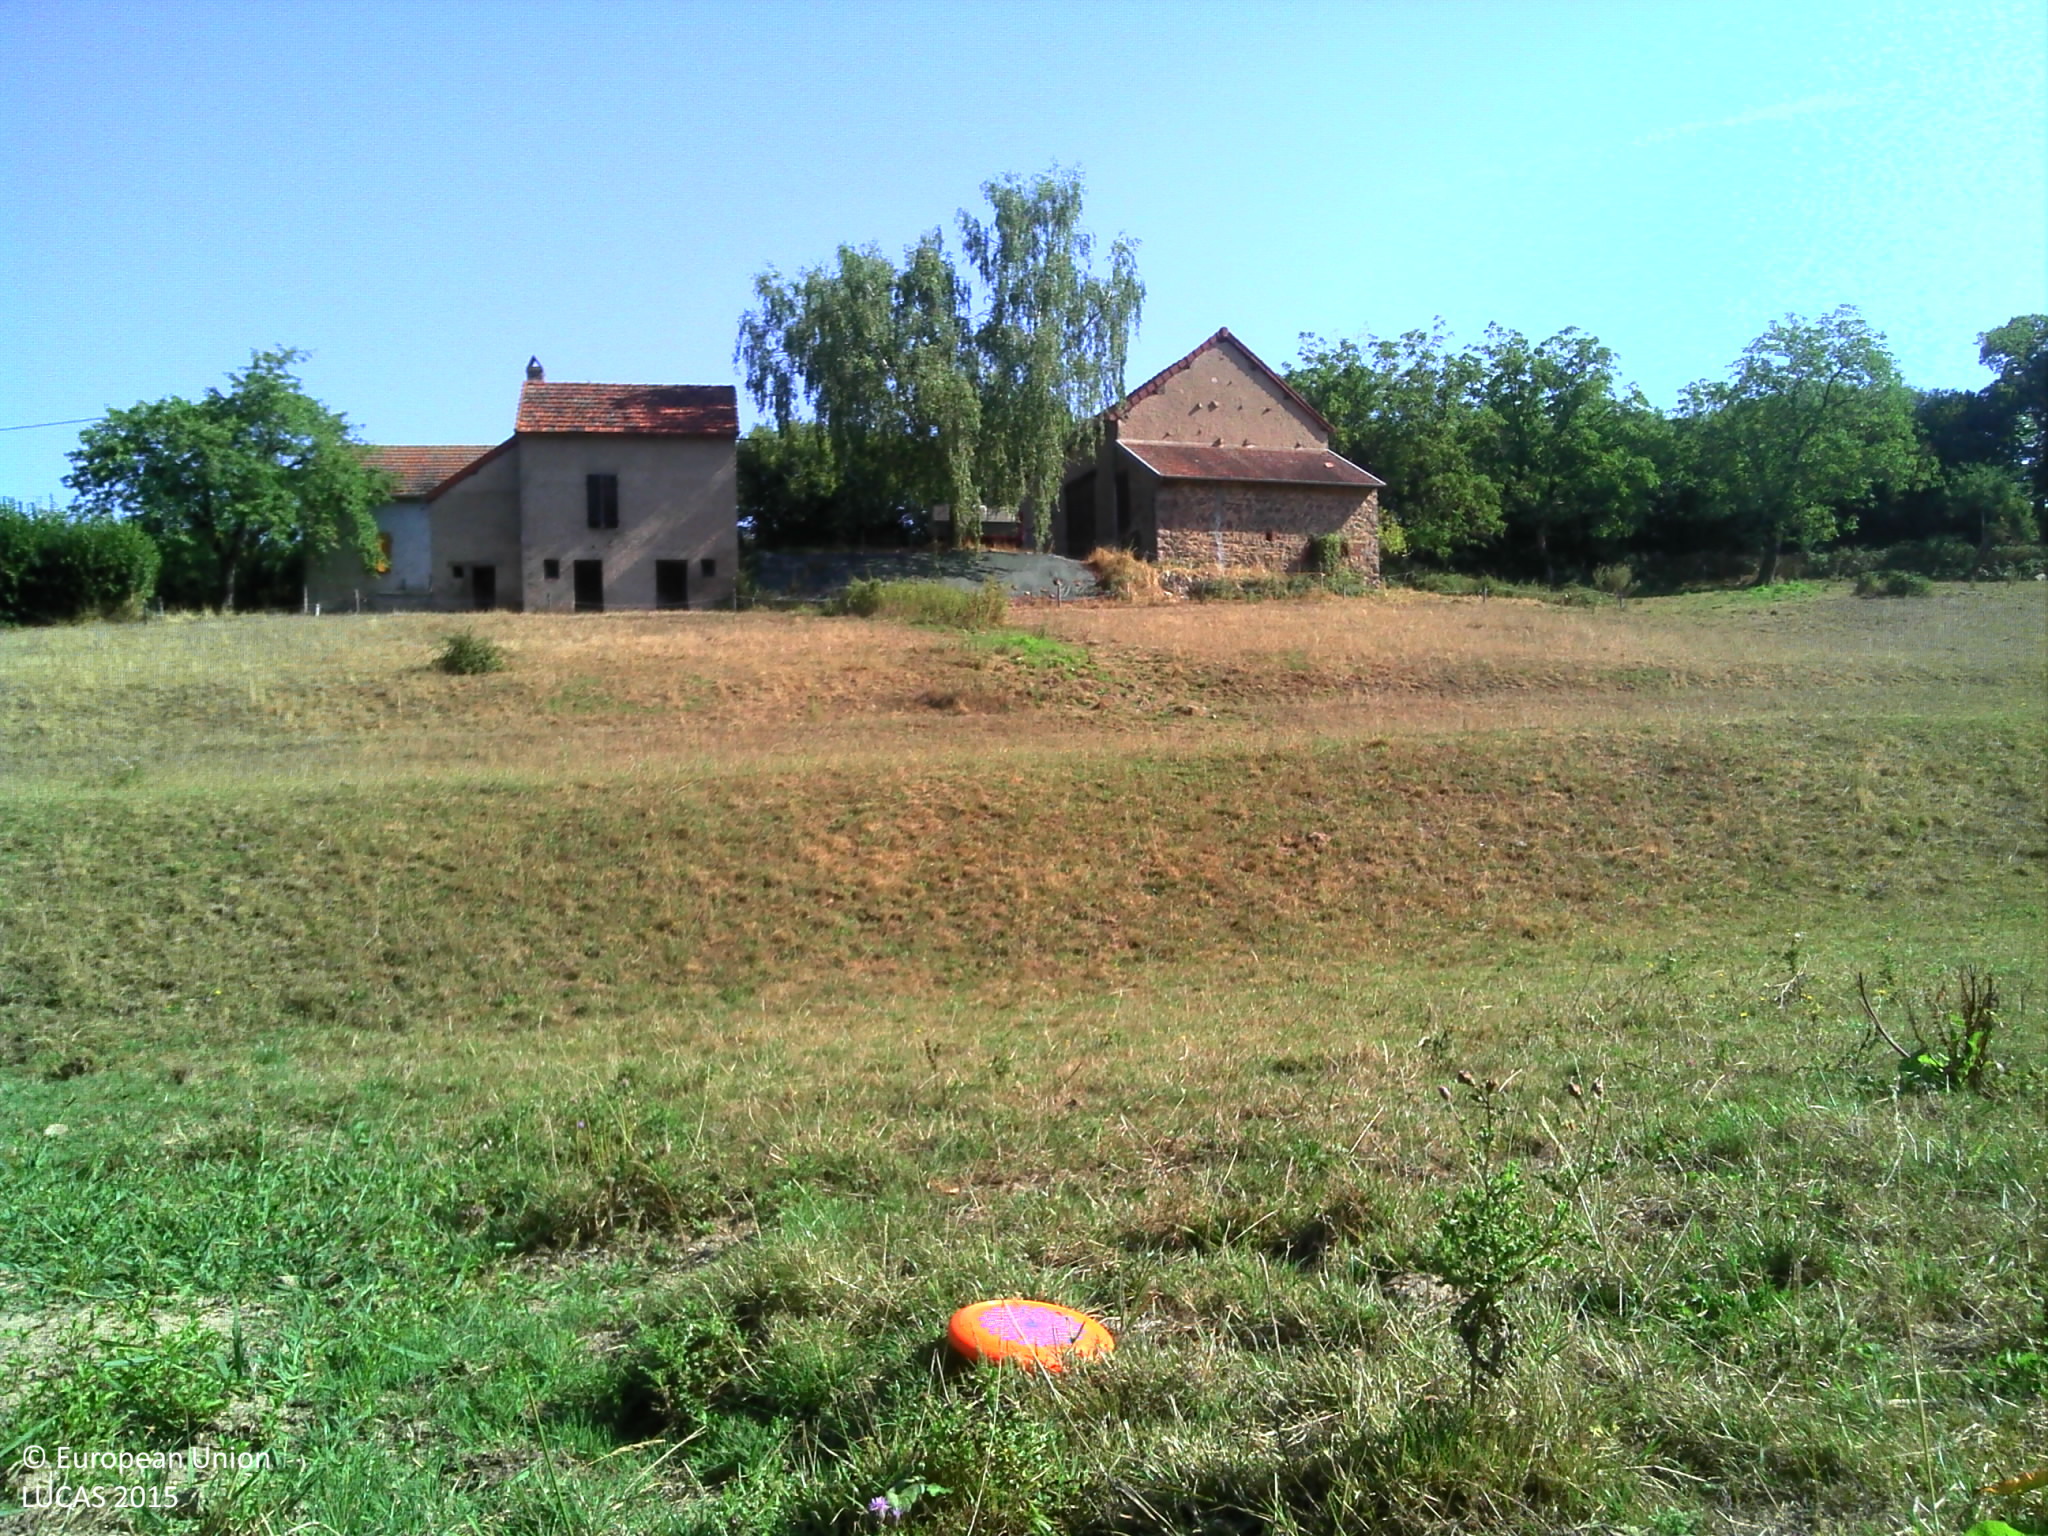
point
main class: Grassland
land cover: Grassland without tree/shrub cover
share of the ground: > 75 %
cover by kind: herbaceous plants 100 %
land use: Agriculture (excluding fallow land and kitchen gardens)
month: August
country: FR
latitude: 46.8171
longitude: 4.3776
